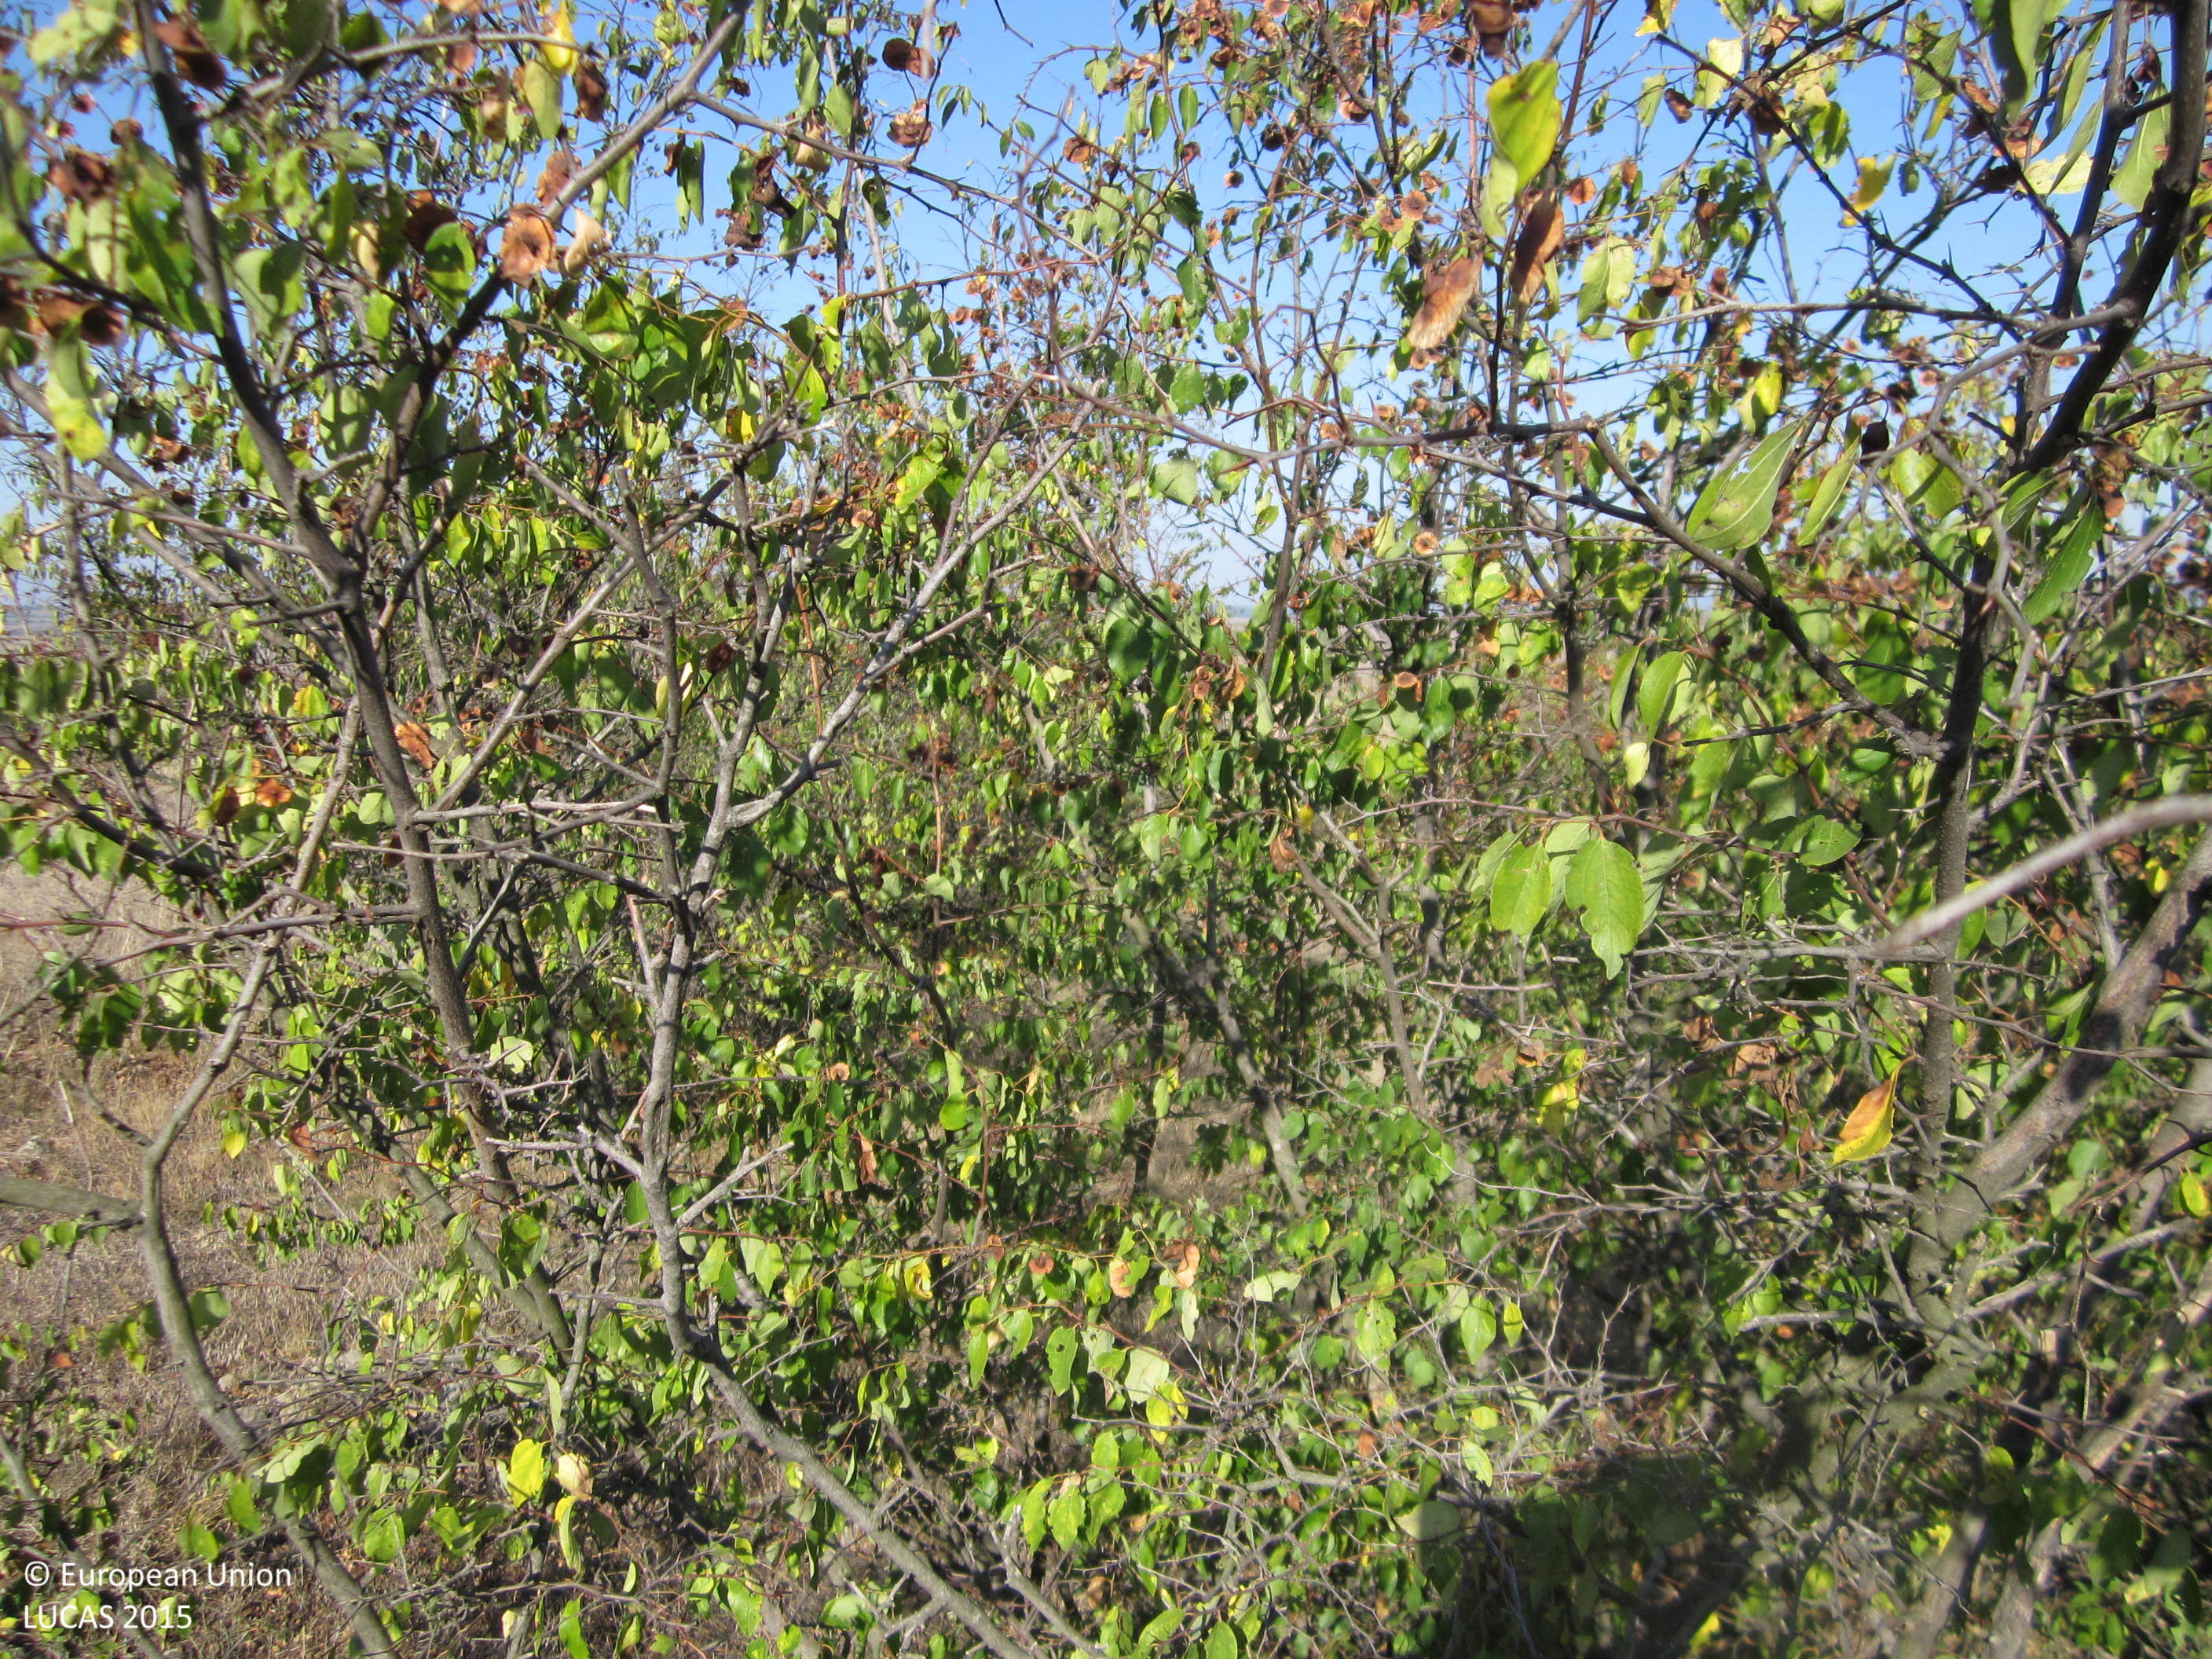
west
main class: Shrubland
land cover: Shrubland without tree cover
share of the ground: 50 - 75 %
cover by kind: shrubs 70 %, herbaceous plants 30 %
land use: Agriculture (excluding fallow land and kitchen gardens)
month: September
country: BG
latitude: 42.6528
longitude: 27.2518
